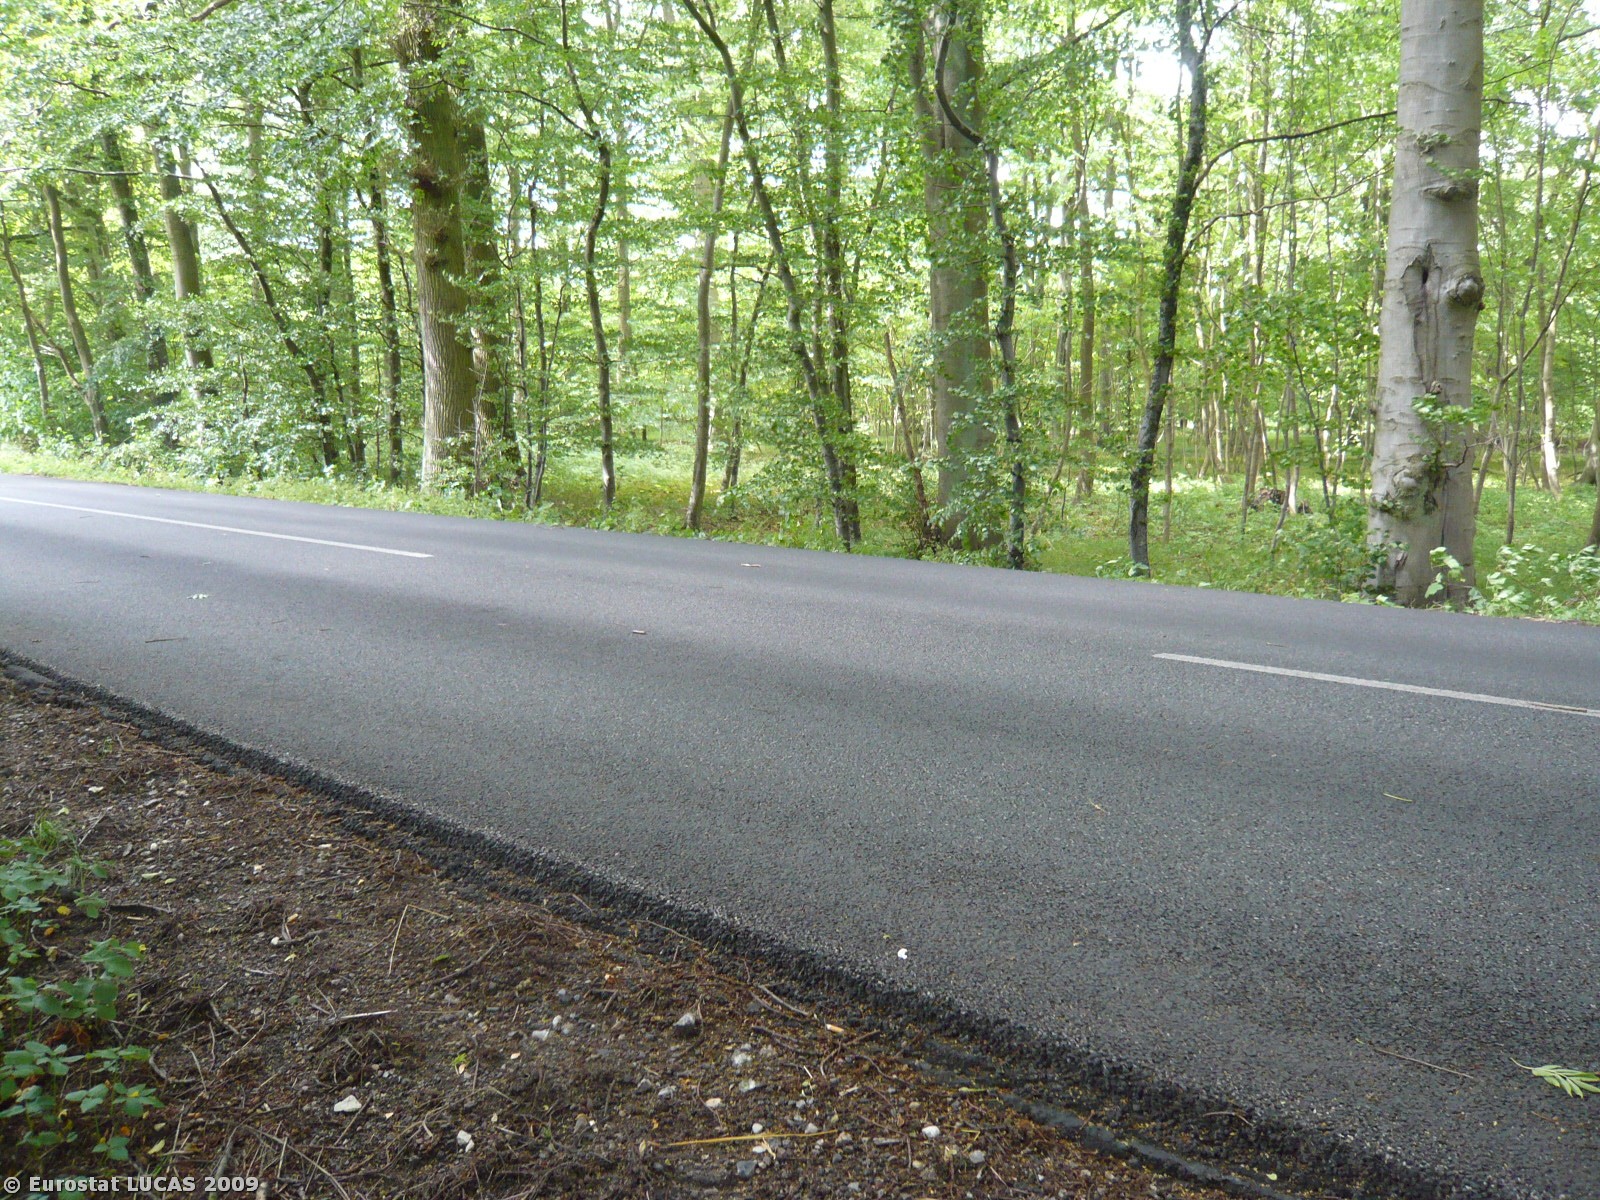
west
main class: Woodland
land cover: Broadleaved woodland
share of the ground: > 75 %
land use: Residential
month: July
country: DK
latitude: 55.4359
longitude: 11.9424
